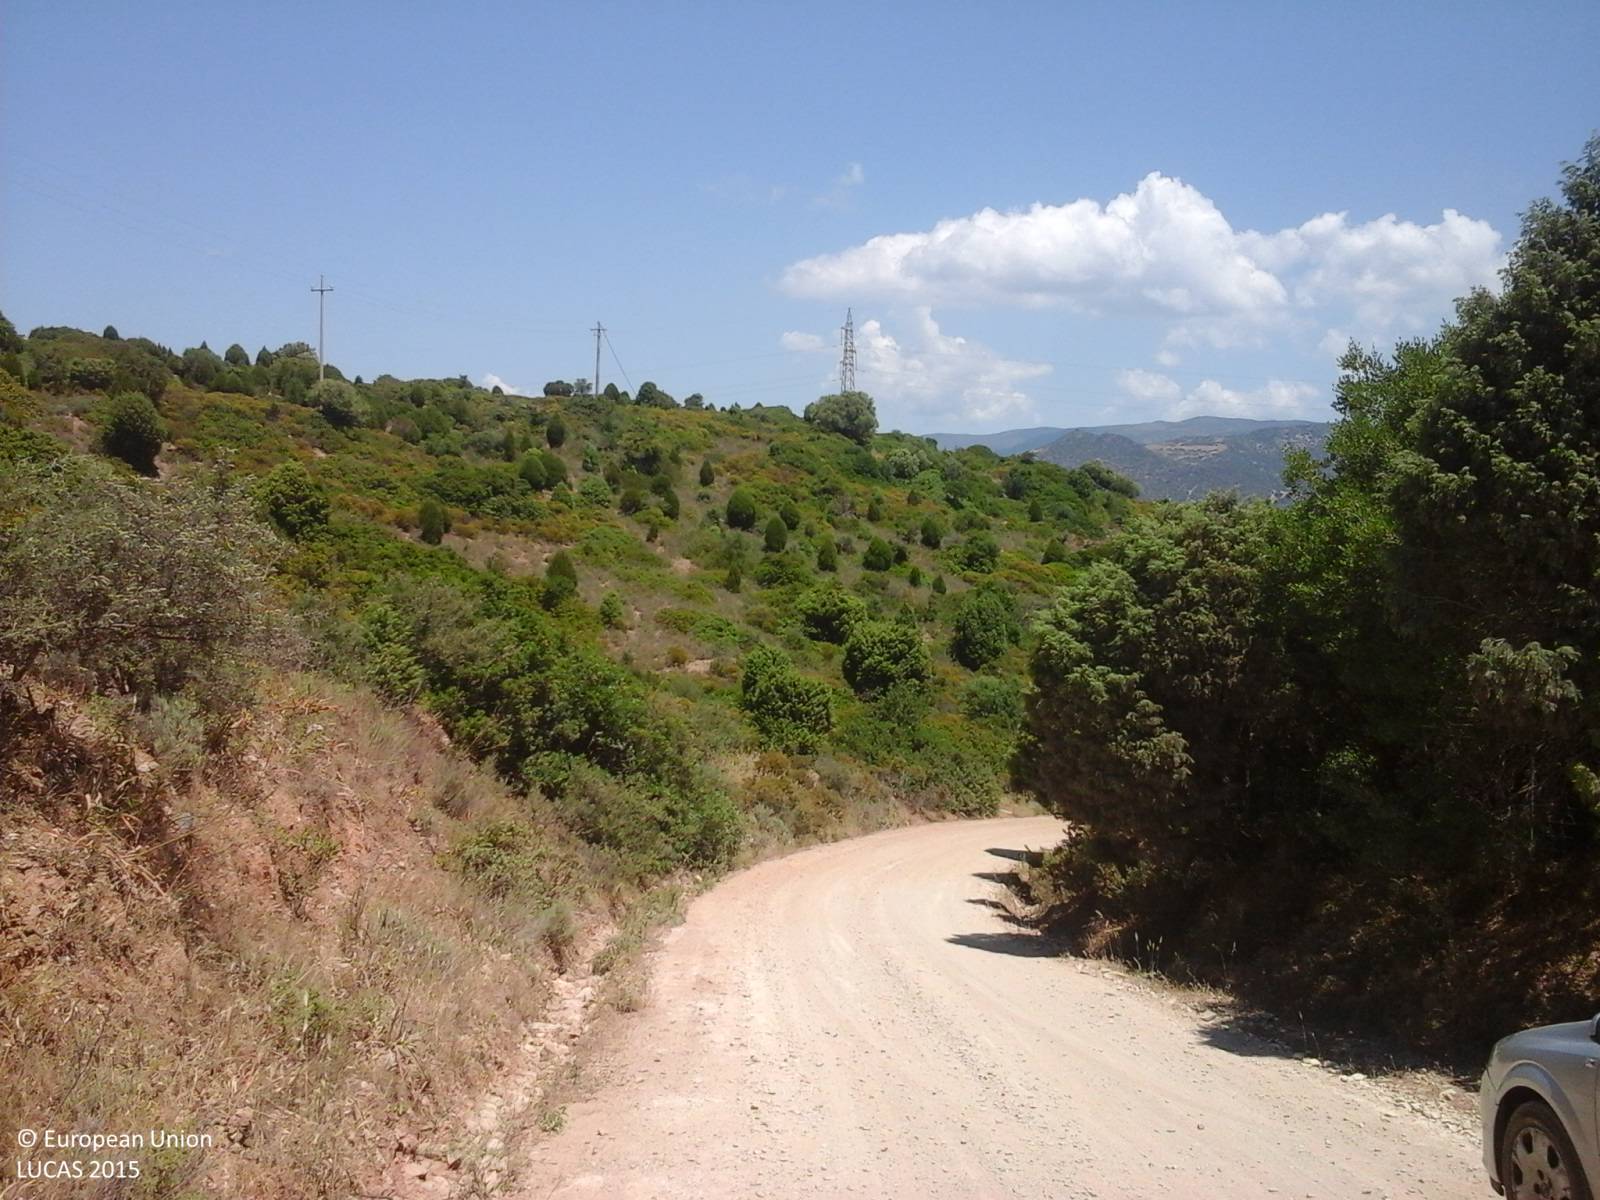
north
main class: Woodland
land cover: Broadleaved woodland
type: broadleaved evergreen forest
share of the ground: > 75 %
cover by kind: broadleaved forest trees 50 %, shrubs 30 %, coniferous forest trees 10 %, herbaceous plants 10 %
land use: Agriculture (excluding fallow land and kitchen gardens)
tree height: > 5 m
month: June
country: IT
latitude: 38.9552
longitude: 8.7732
